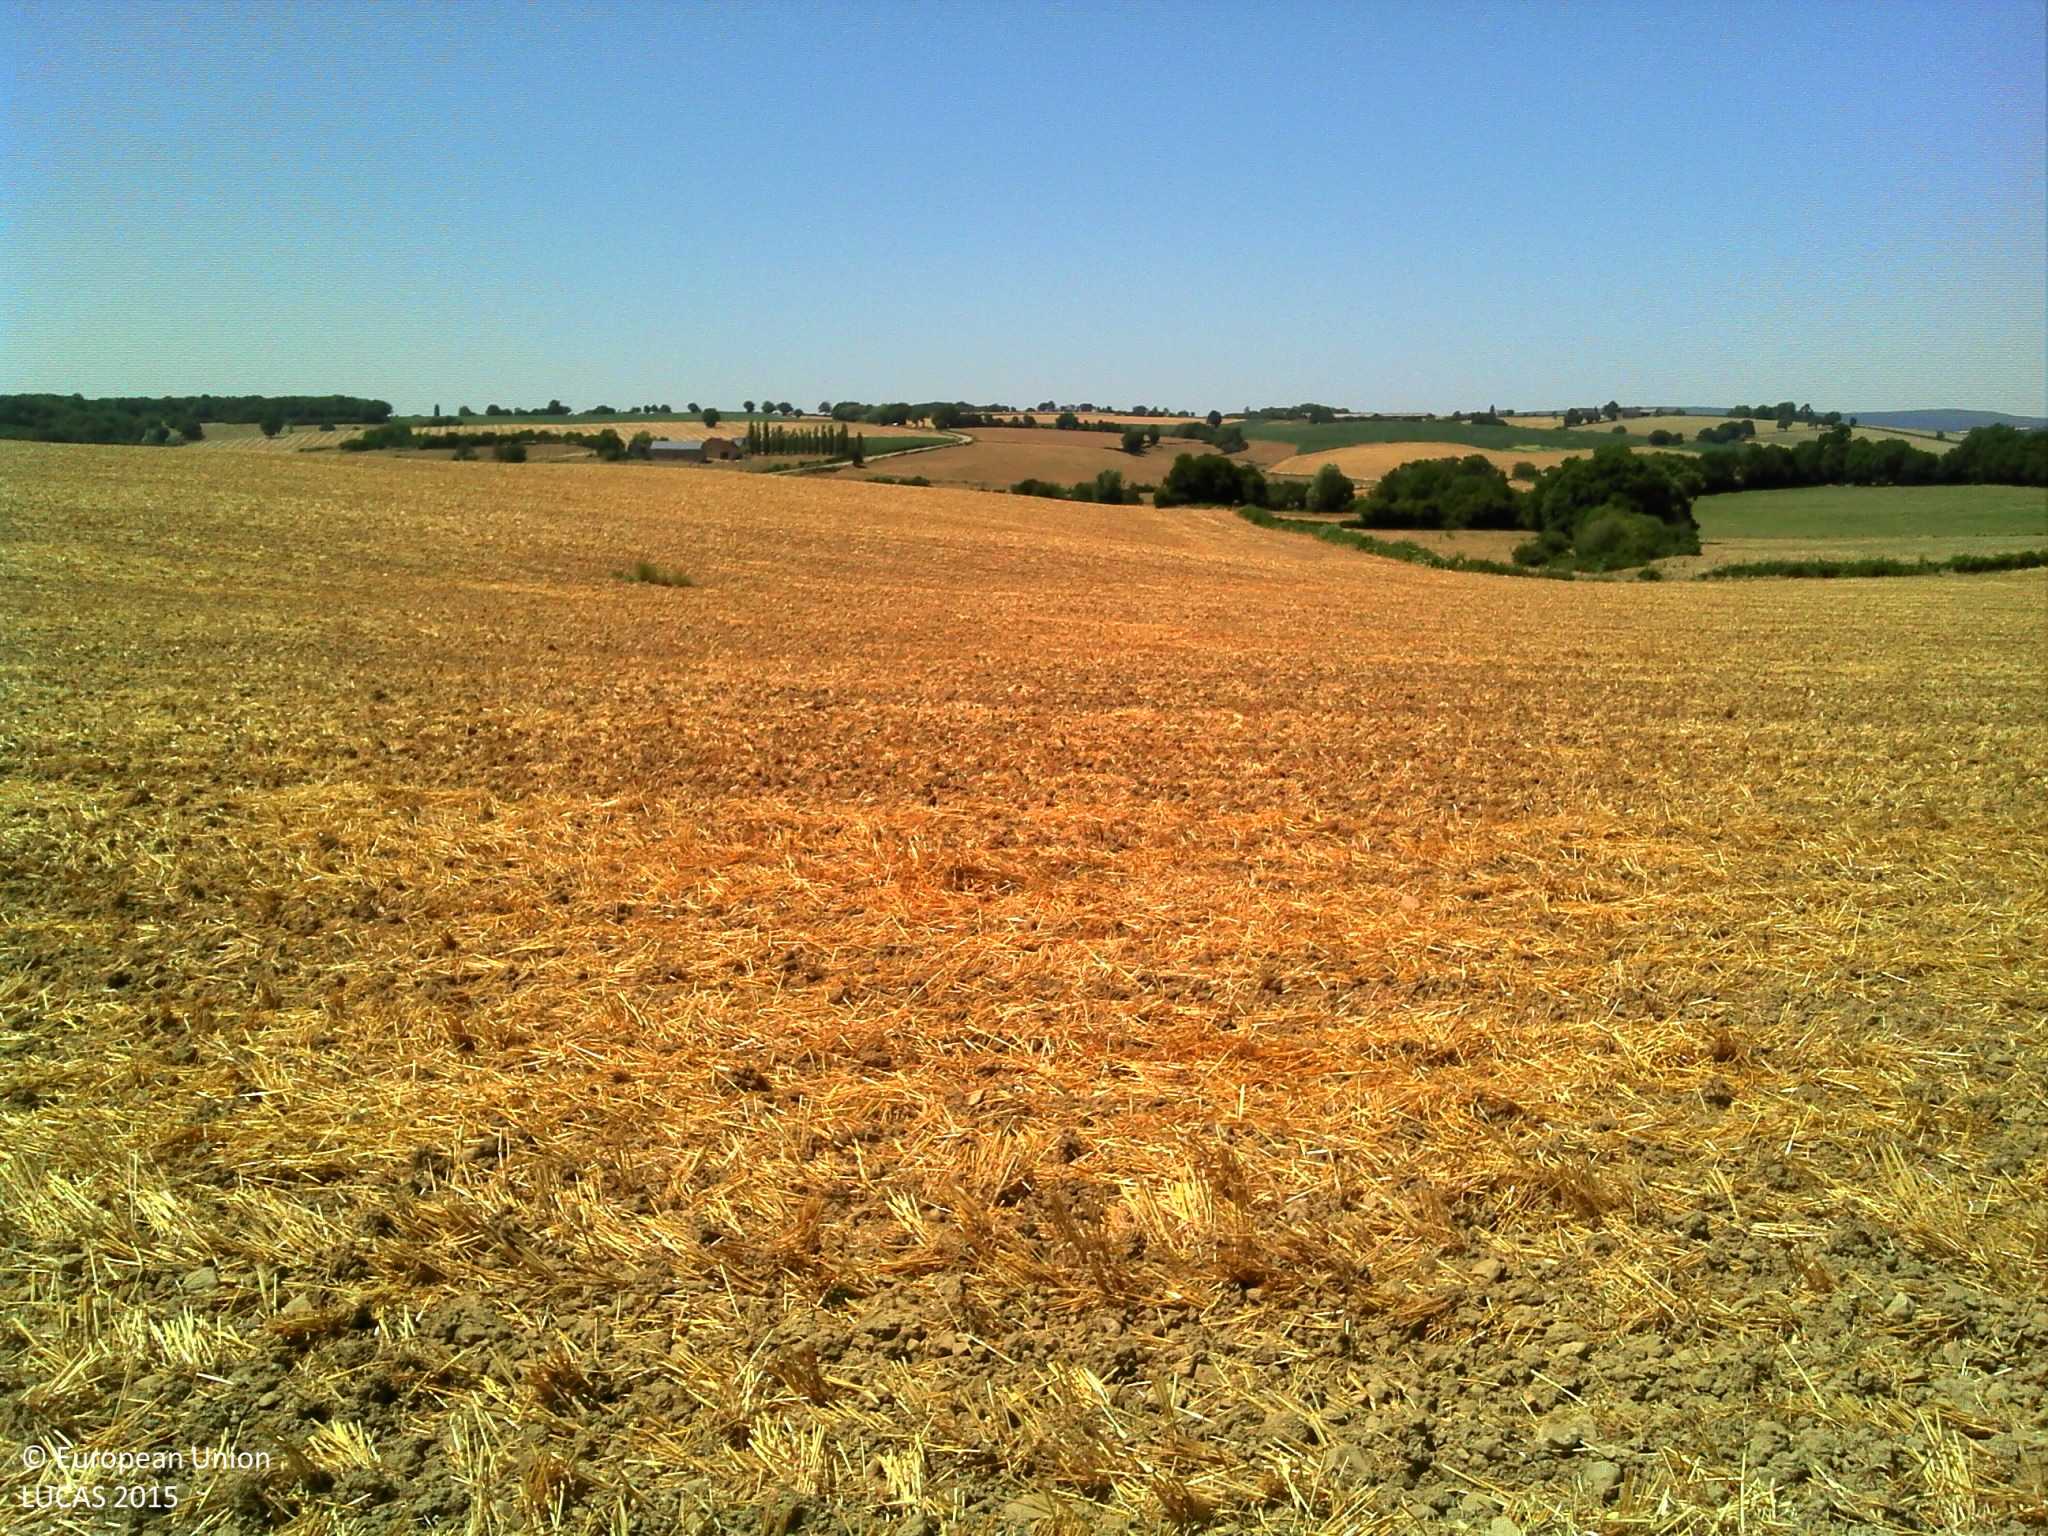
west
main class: Cropland
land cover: Barley
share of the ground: > 75 %
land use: Agriculture (excluding fallow land and kitchen gardens)
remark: Harvested field
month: July
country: FR
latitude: 46.9152
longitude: 3.5508
